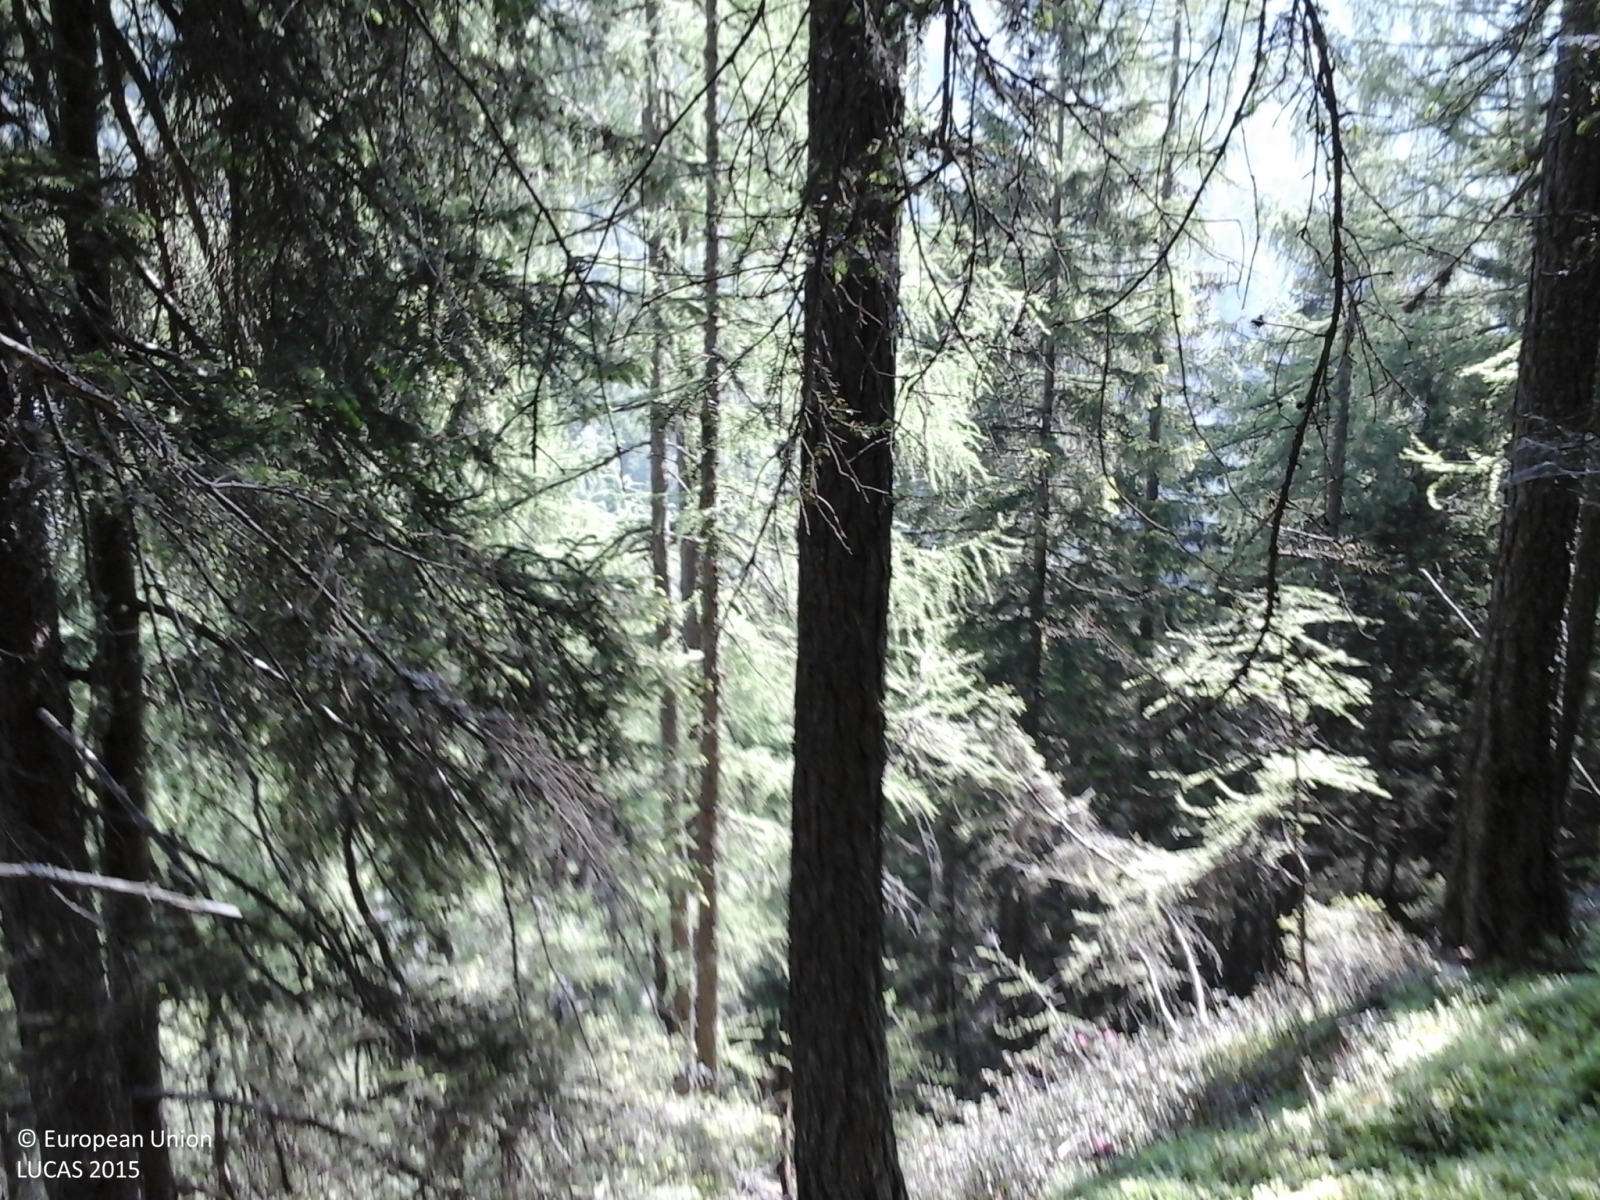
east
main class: Woodland
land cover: Spruce dominated coniferous woodland
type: alpine coniferous forest
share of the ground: > 75 %
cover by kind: coniferous forest trees 100 %
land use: Forestry
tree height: > 5 m
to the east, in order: Spruce dominated coniferous woodland; Tracks; Spruce dominated coniferous woodland; Fences; Spruce dominated coniferous woodland; Grassland without tree/shrub cover; Electric lines; Grassland without tree/shrub cover; Artificial constructions in urban areas
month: June
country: IT
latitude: 46.7076
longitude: 10.9015
